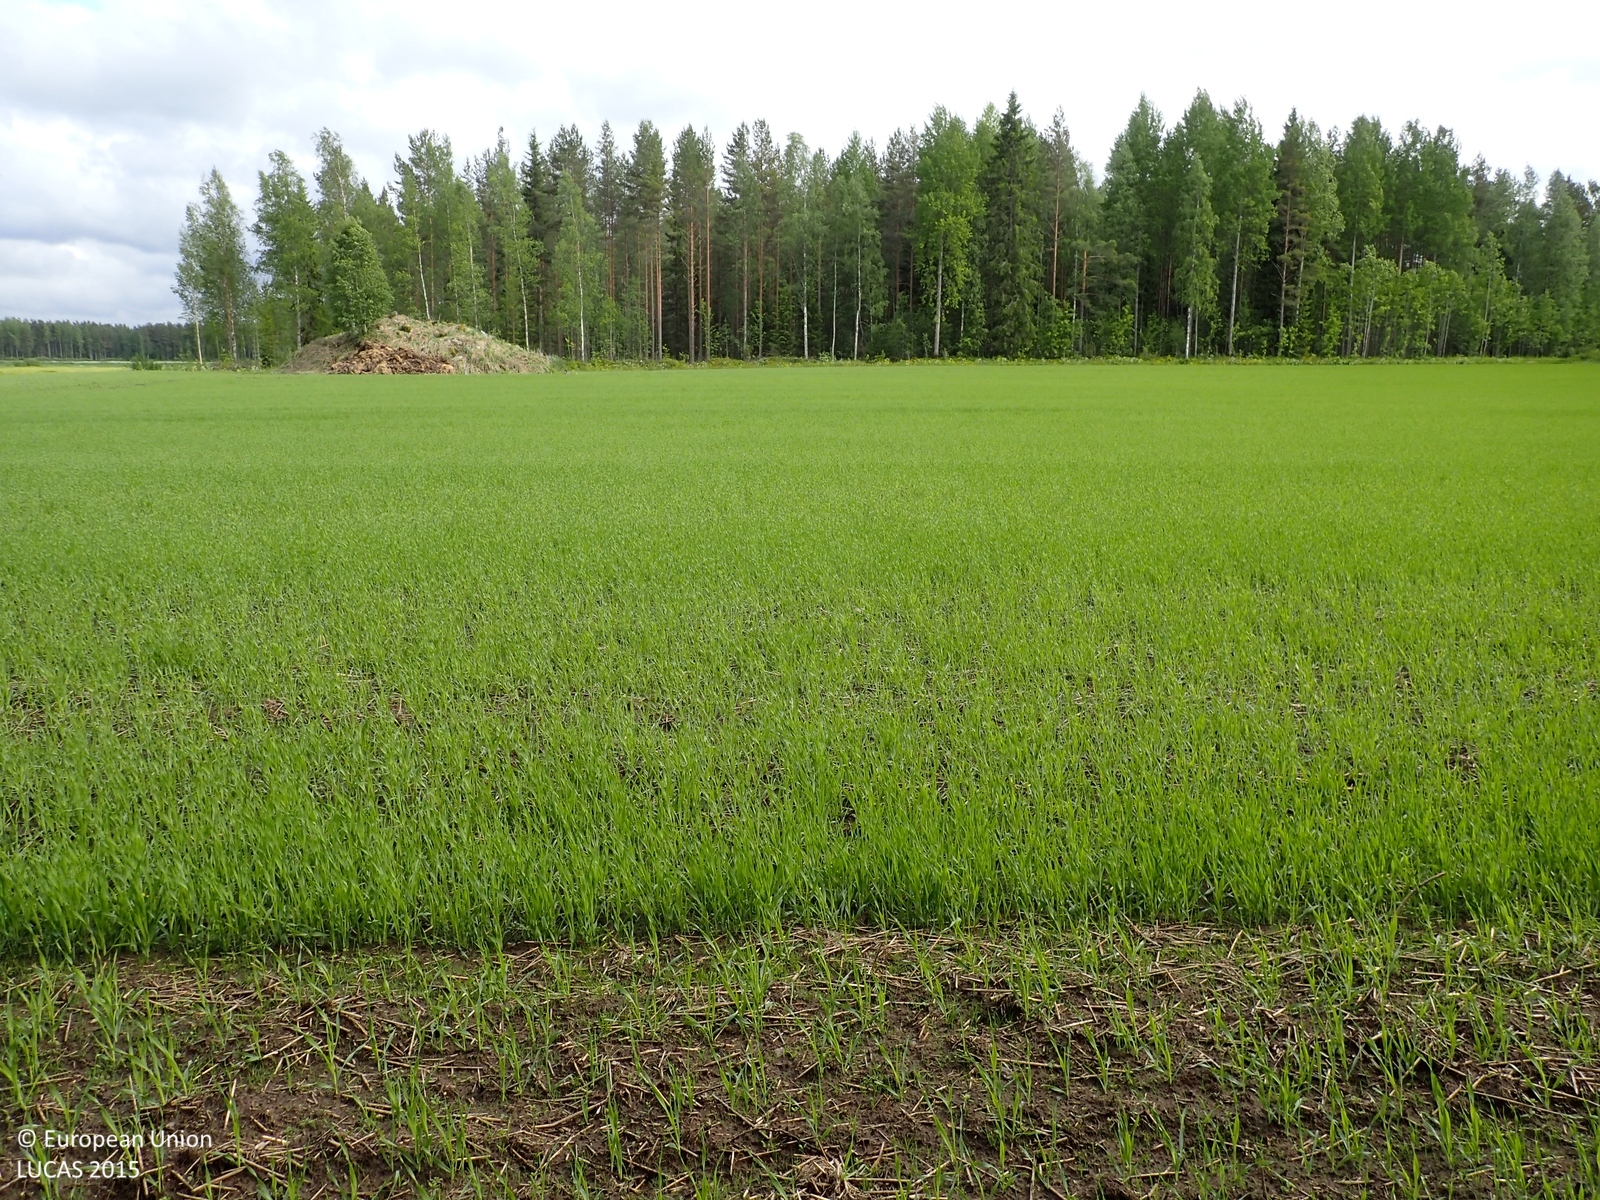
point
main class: Cropland
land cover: Barley
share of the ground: > 75 %
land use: Agriculture (excluding fallow land and kitchen gardens)
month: June
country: FI
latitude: 62.3381
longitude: 21.6894
